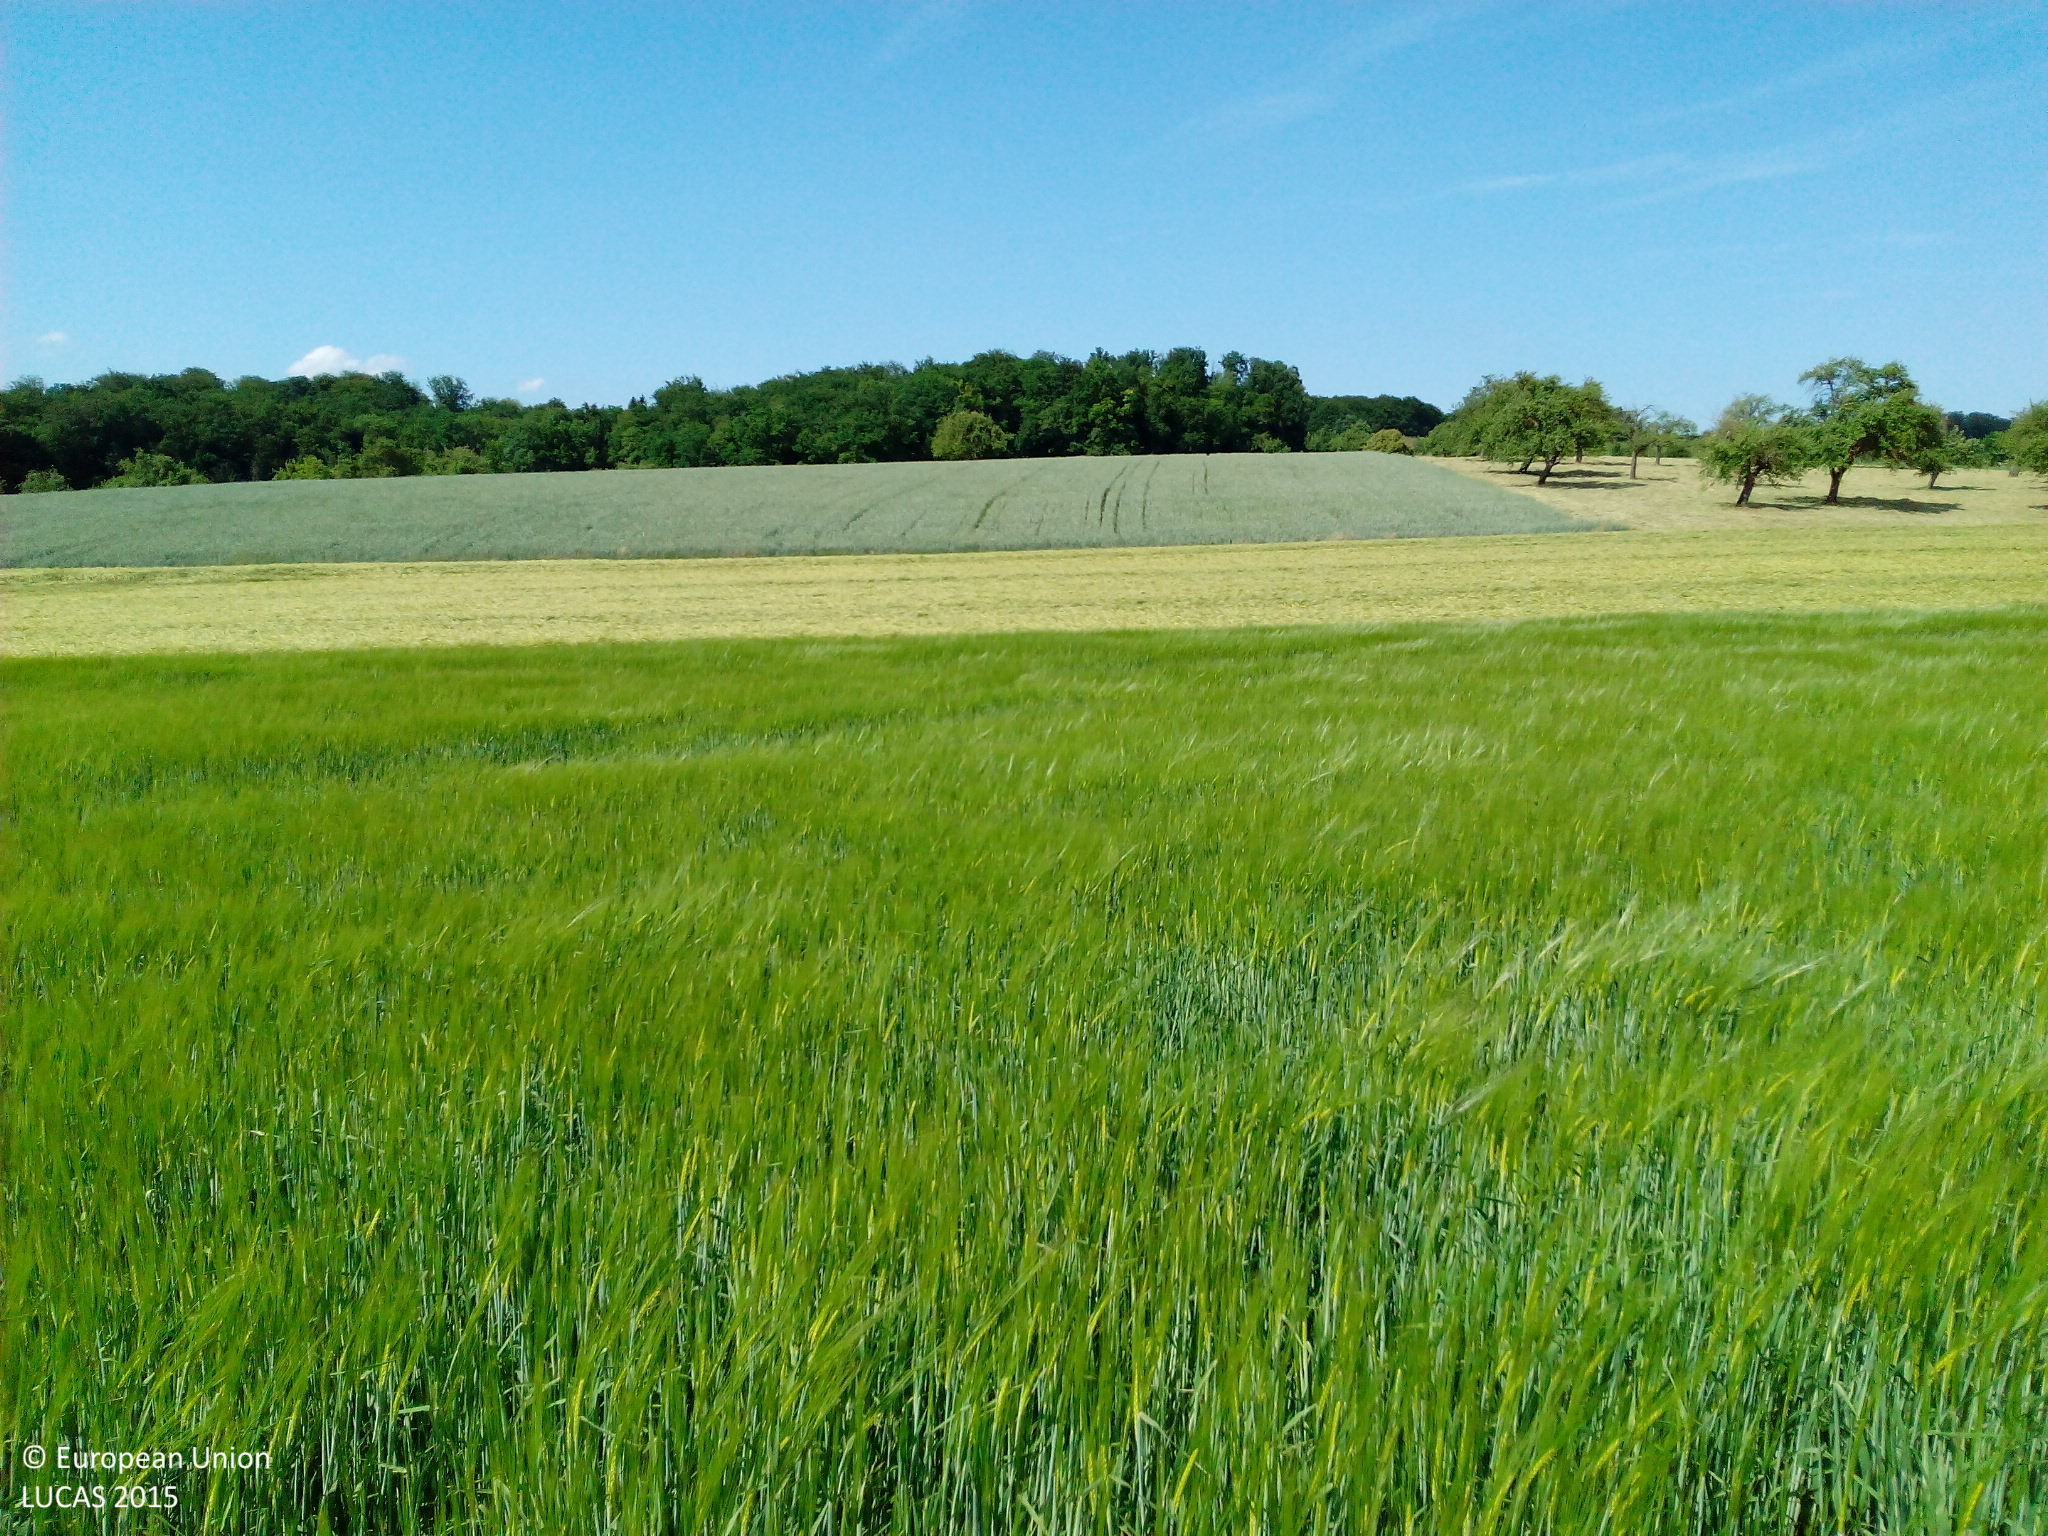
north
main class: Artificial land
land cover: Other artificial areas
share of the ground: < 10 %
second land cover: Barley
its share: > 75 %
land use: Electricity, gas and thermal power distribution
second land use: Agriculture (excluding fallow land and kitchen gardens)
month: June
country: DE
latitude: 48.9051
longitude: 9.3045
